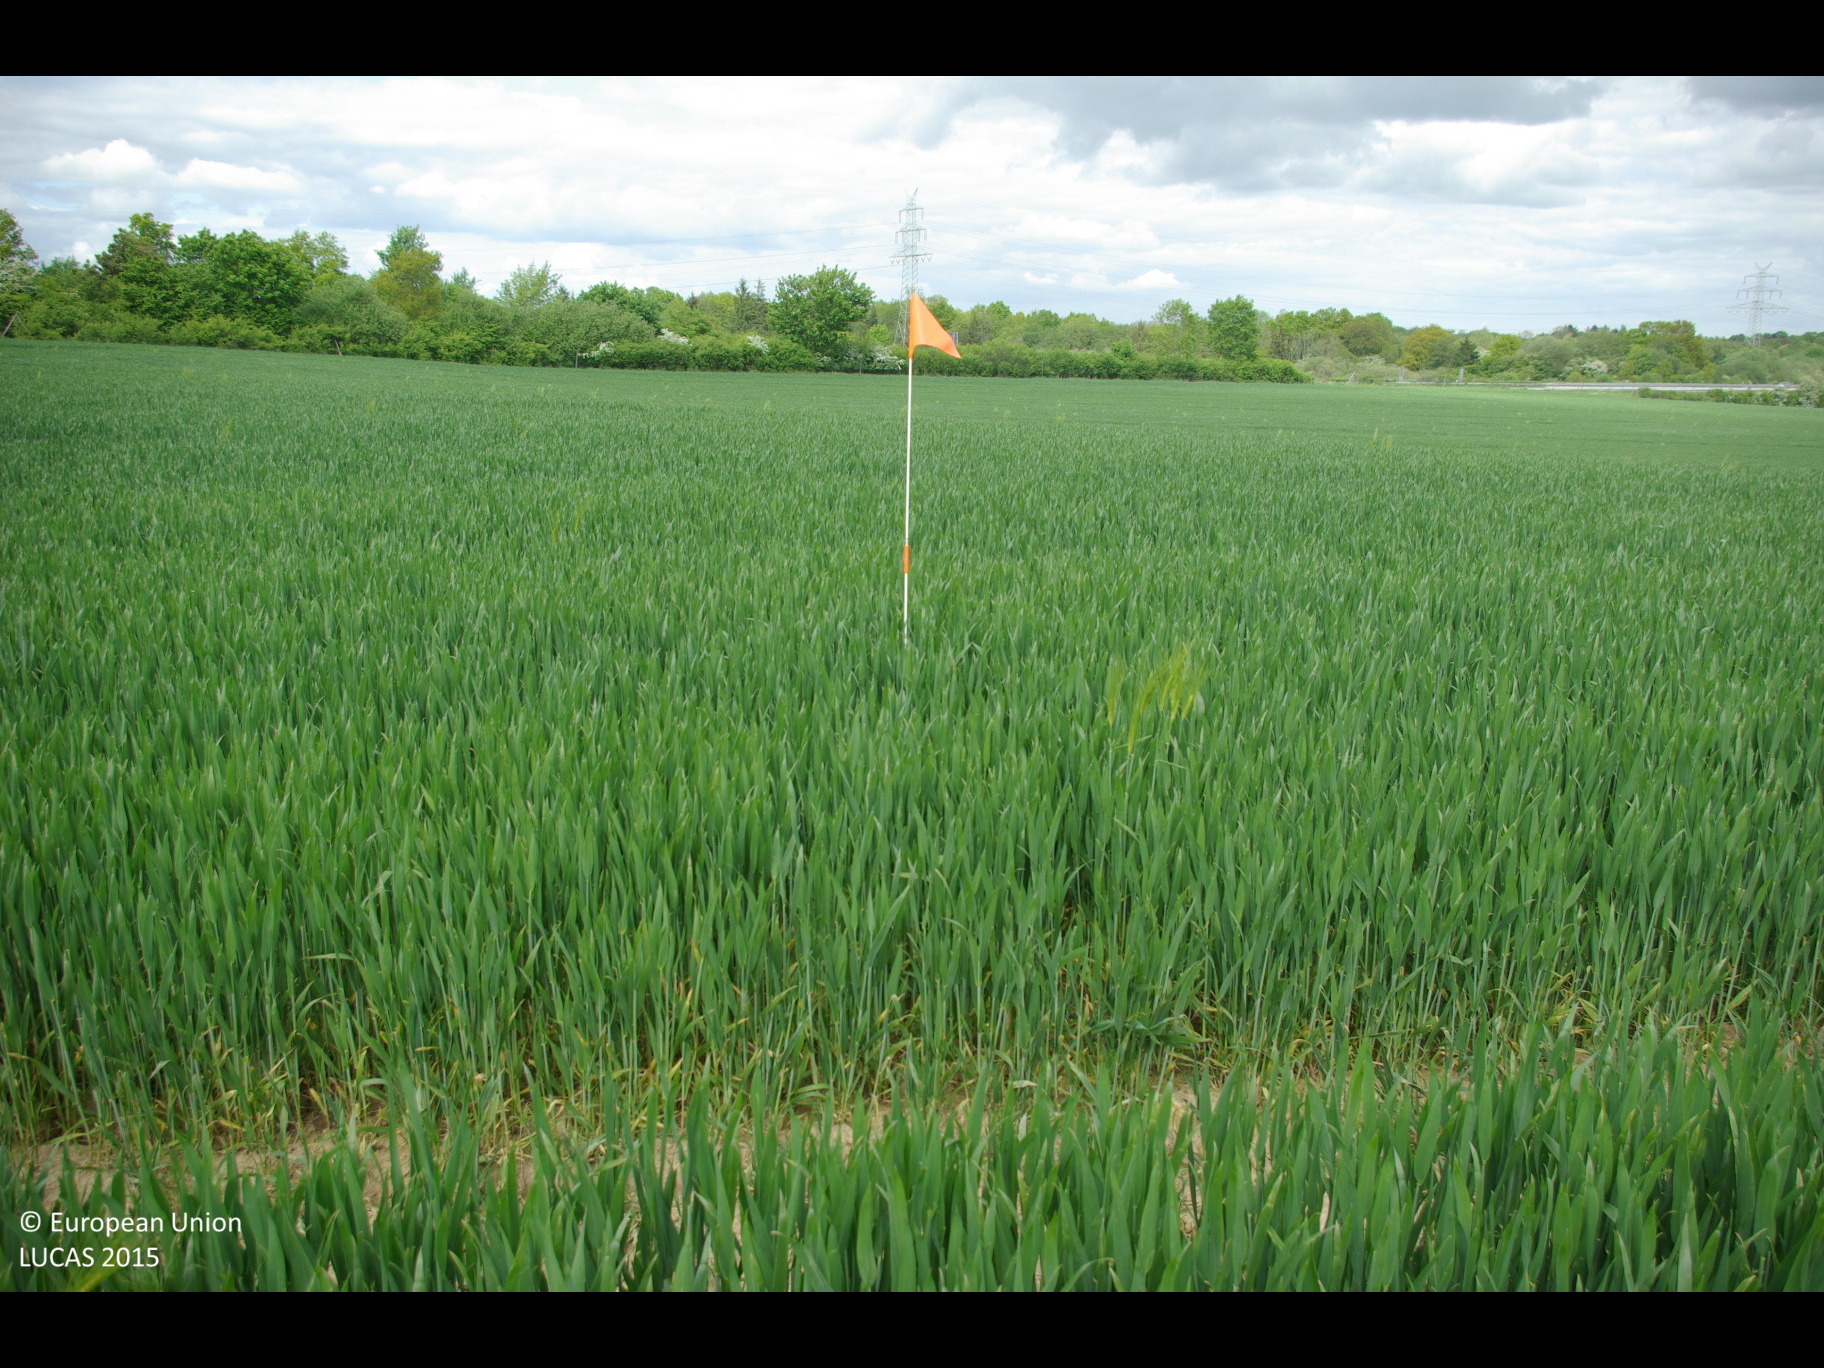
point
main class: Cropland
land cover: Common wheat
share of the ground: > 75 %
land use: Agriculture (excluding fallow land and kitchen gardens)
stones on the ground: < 10 %
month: May
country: DE
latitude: 54.3185
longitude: 9.9539
